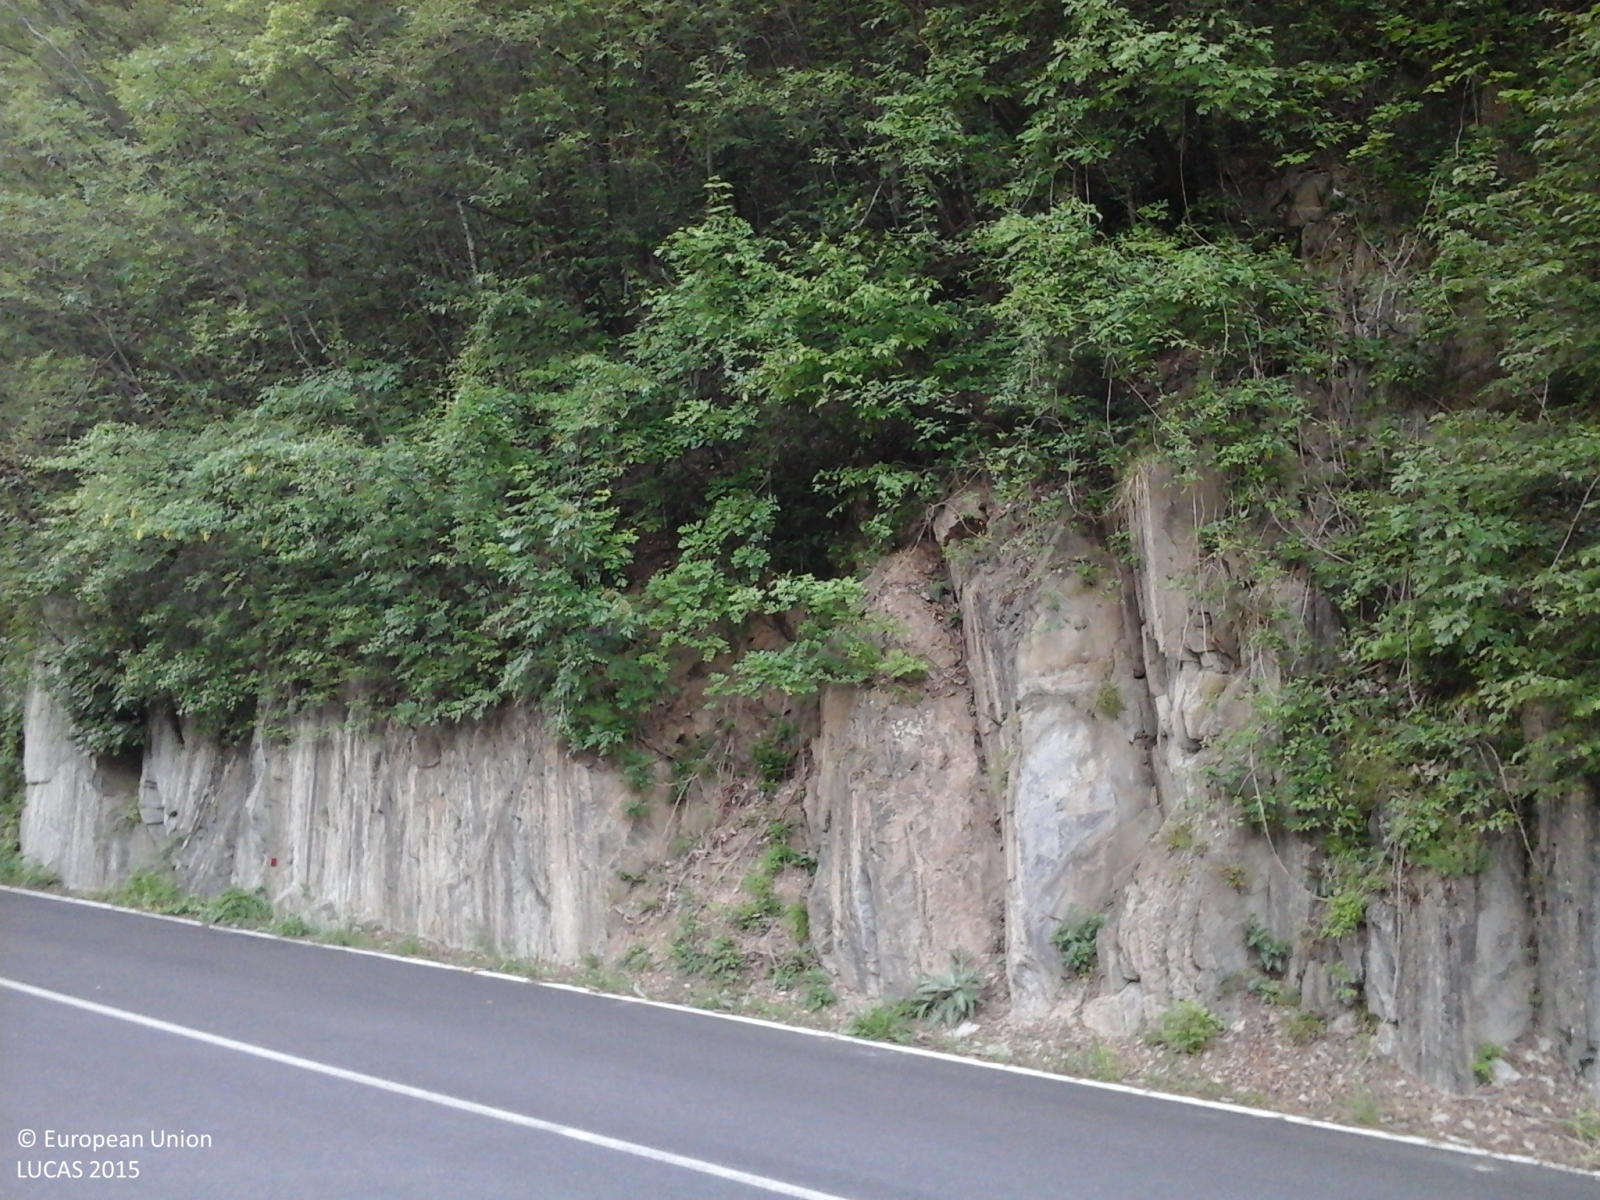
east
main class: Woodland
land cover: Broadleaved woodland
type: mesophytic deciduous forest
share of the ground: > 75 %
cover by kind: broadleaved forest trees 100 %
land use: Forestry
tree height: > 5 m
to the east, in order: Broadleaved woodland; Inland fresh running water; Broadleaved woodland
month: May
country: IT
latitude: 44.7274
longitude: 9.3826
